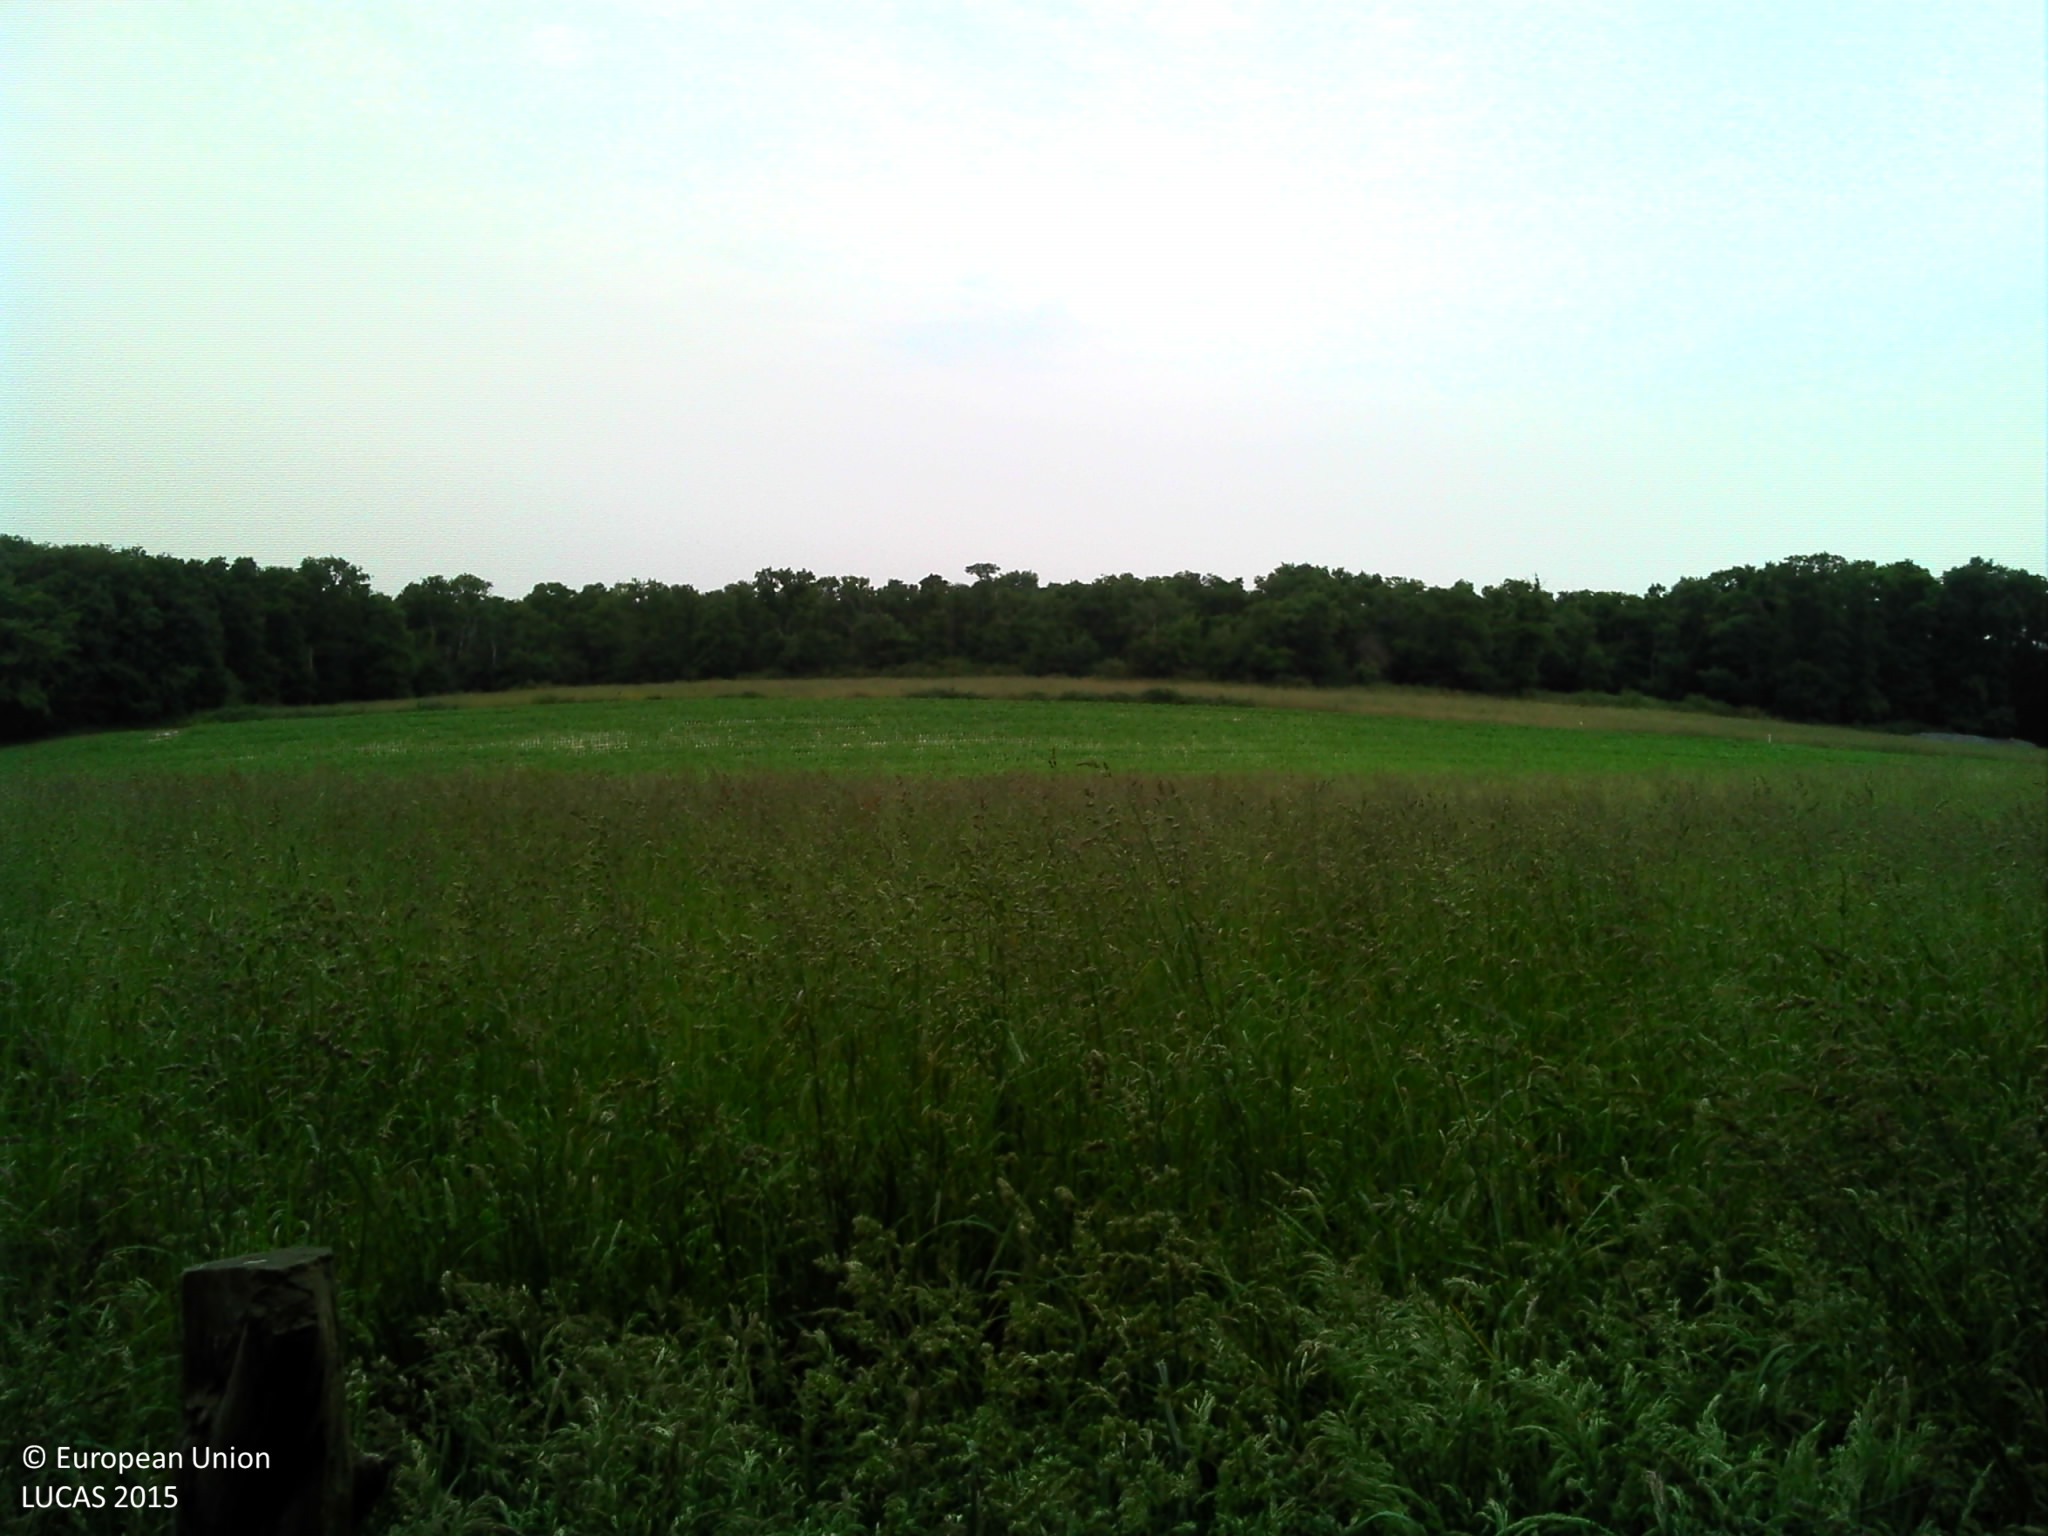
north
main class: Grassland
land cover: Grassland without tree/shrub cover
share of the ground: > 75 %
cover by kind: herbaceous plants 100 %
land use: Agriculture (excluding fallow land and kitchen gardens)
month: June
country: FR
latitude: 48.1148
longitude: -2.1301
